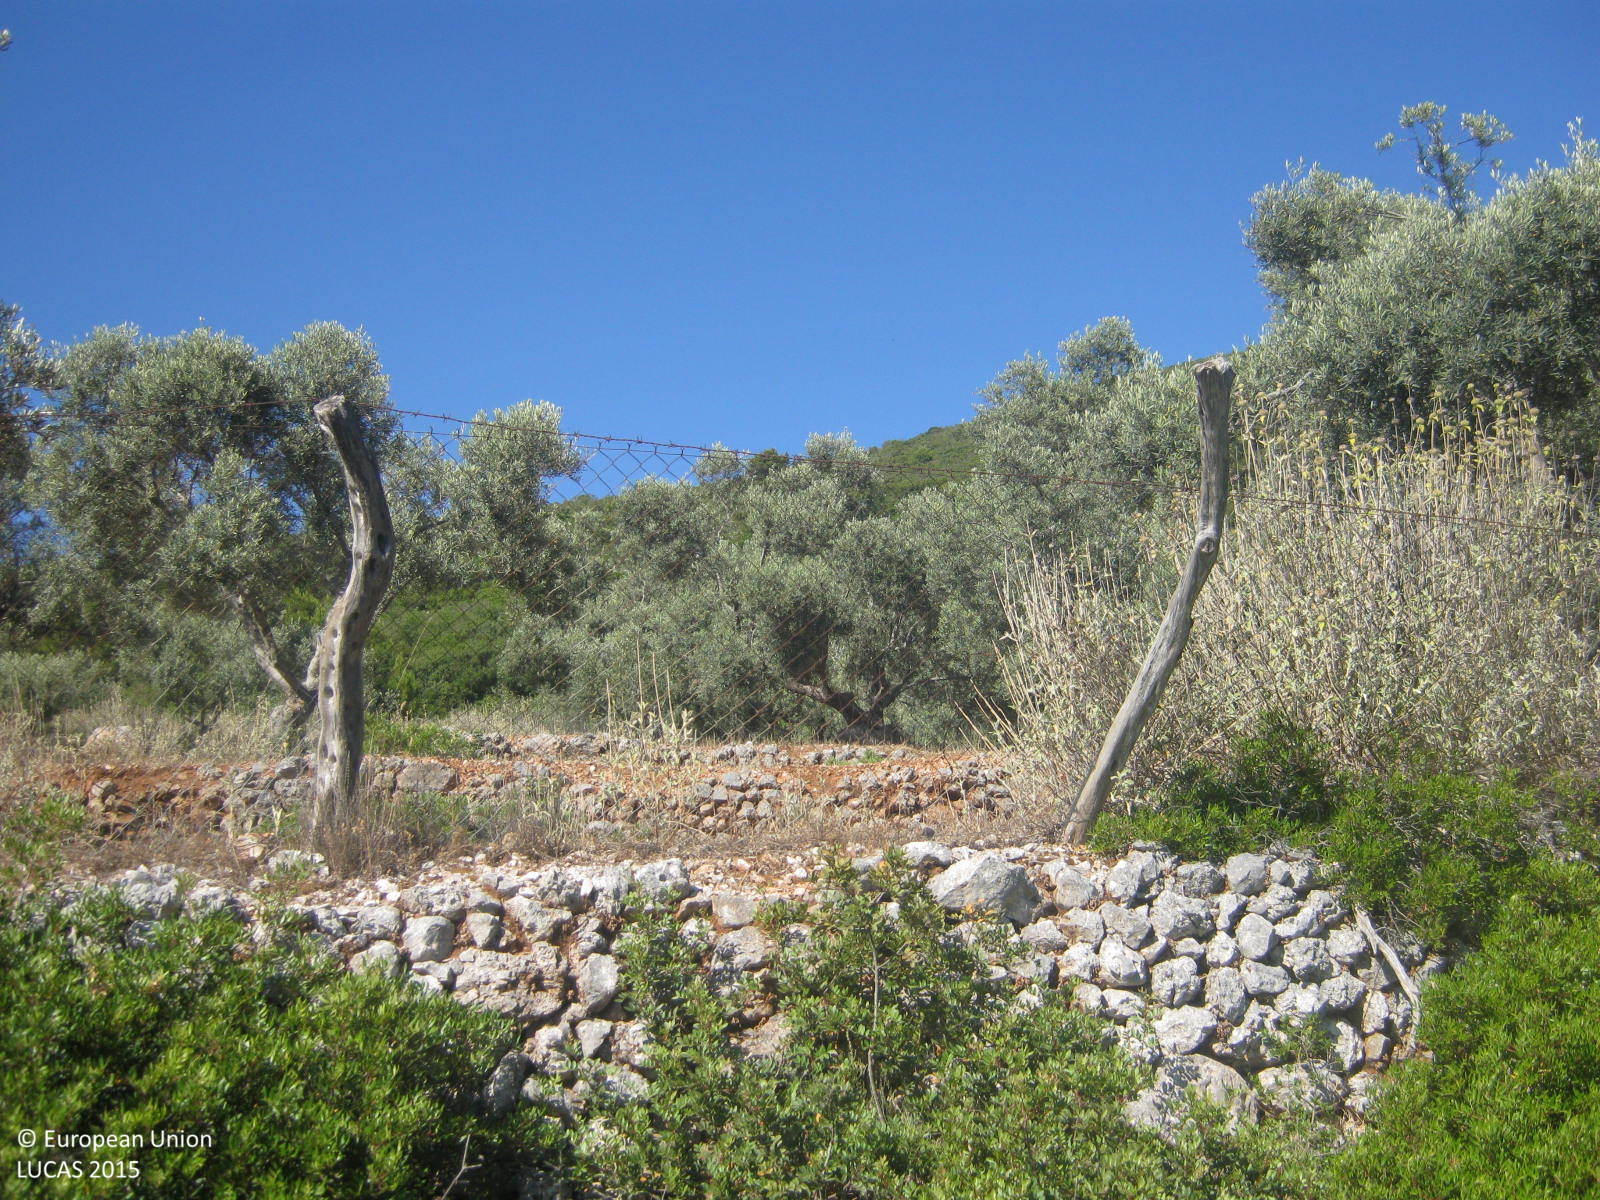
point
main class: Shrubland
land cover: Shrubland with sparse tree cover
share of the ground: > 75 %
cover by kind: shrubs 80 %, unconsolidated bare surface 15 %, coniferous forest trees 5 %
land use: Semi-natural and natural areas not in use
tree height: < 5 m
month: June
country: GR
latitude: 38.6186
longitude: 20.5667
